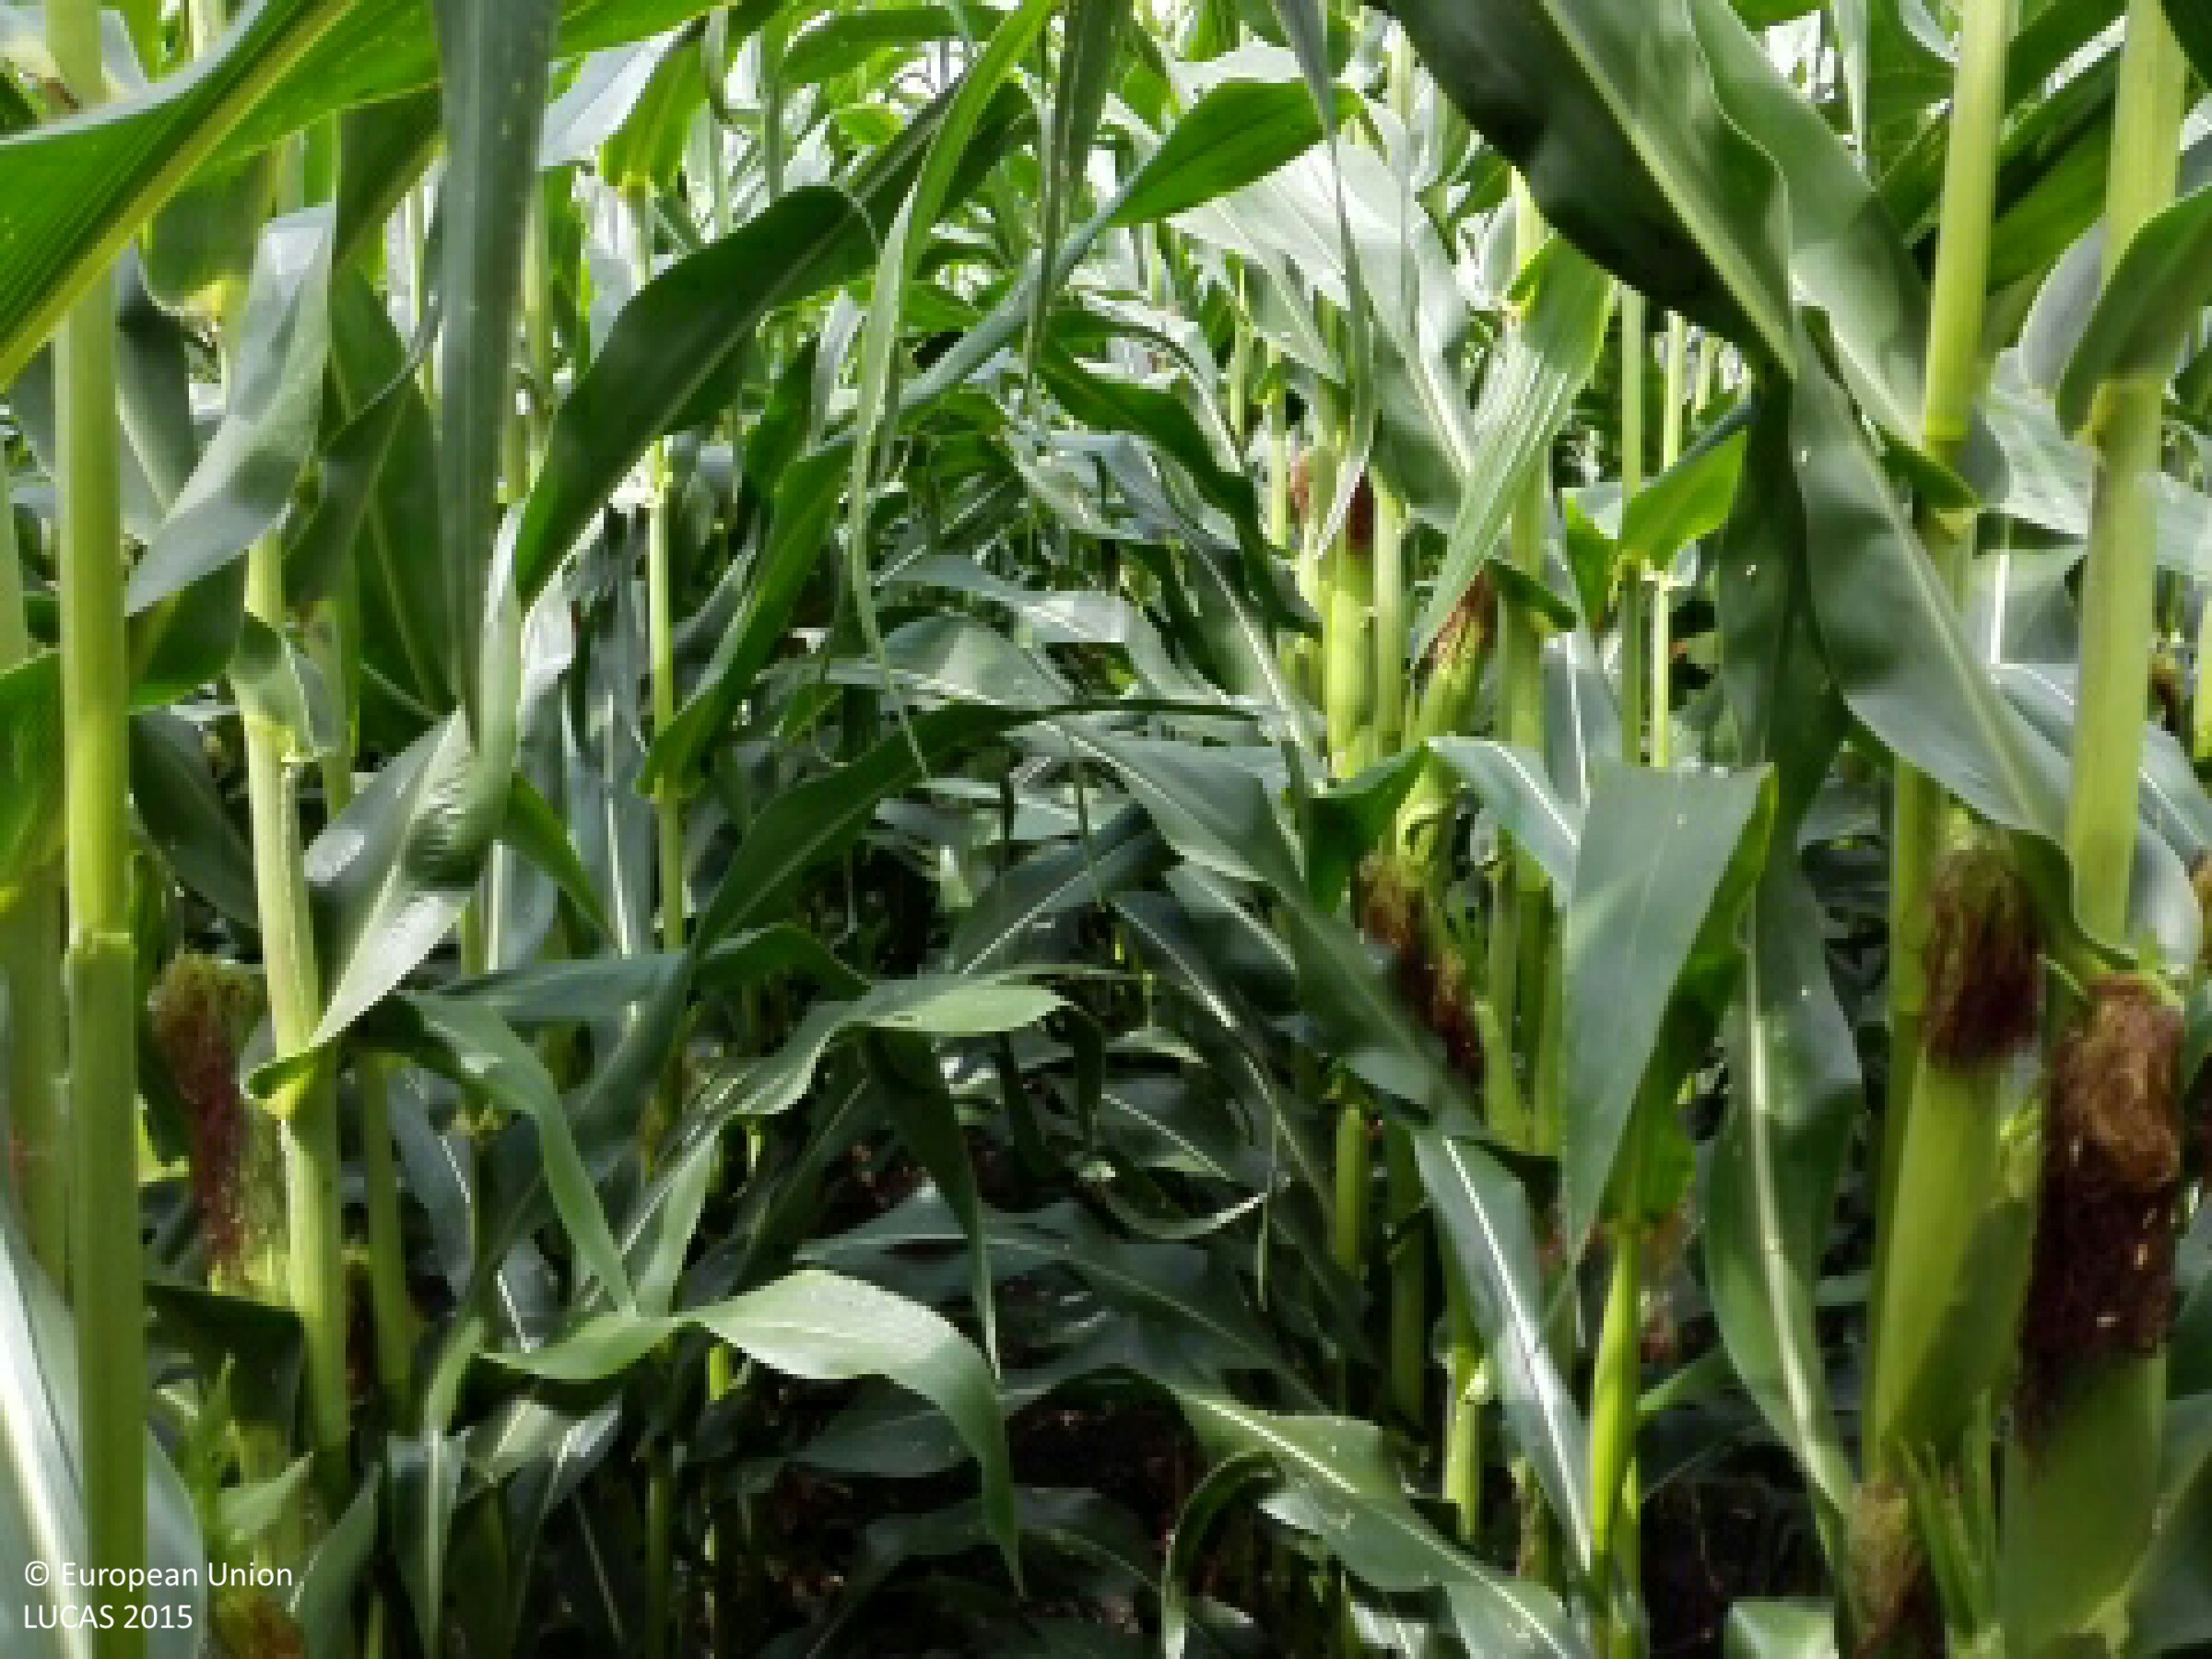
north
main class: Cropland
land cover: Maize
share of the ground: > 75 %
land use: Agriculture (excluding fallow land and kitchen gardens)
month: July
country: HU
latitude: 47.5596
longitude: 21.3781
